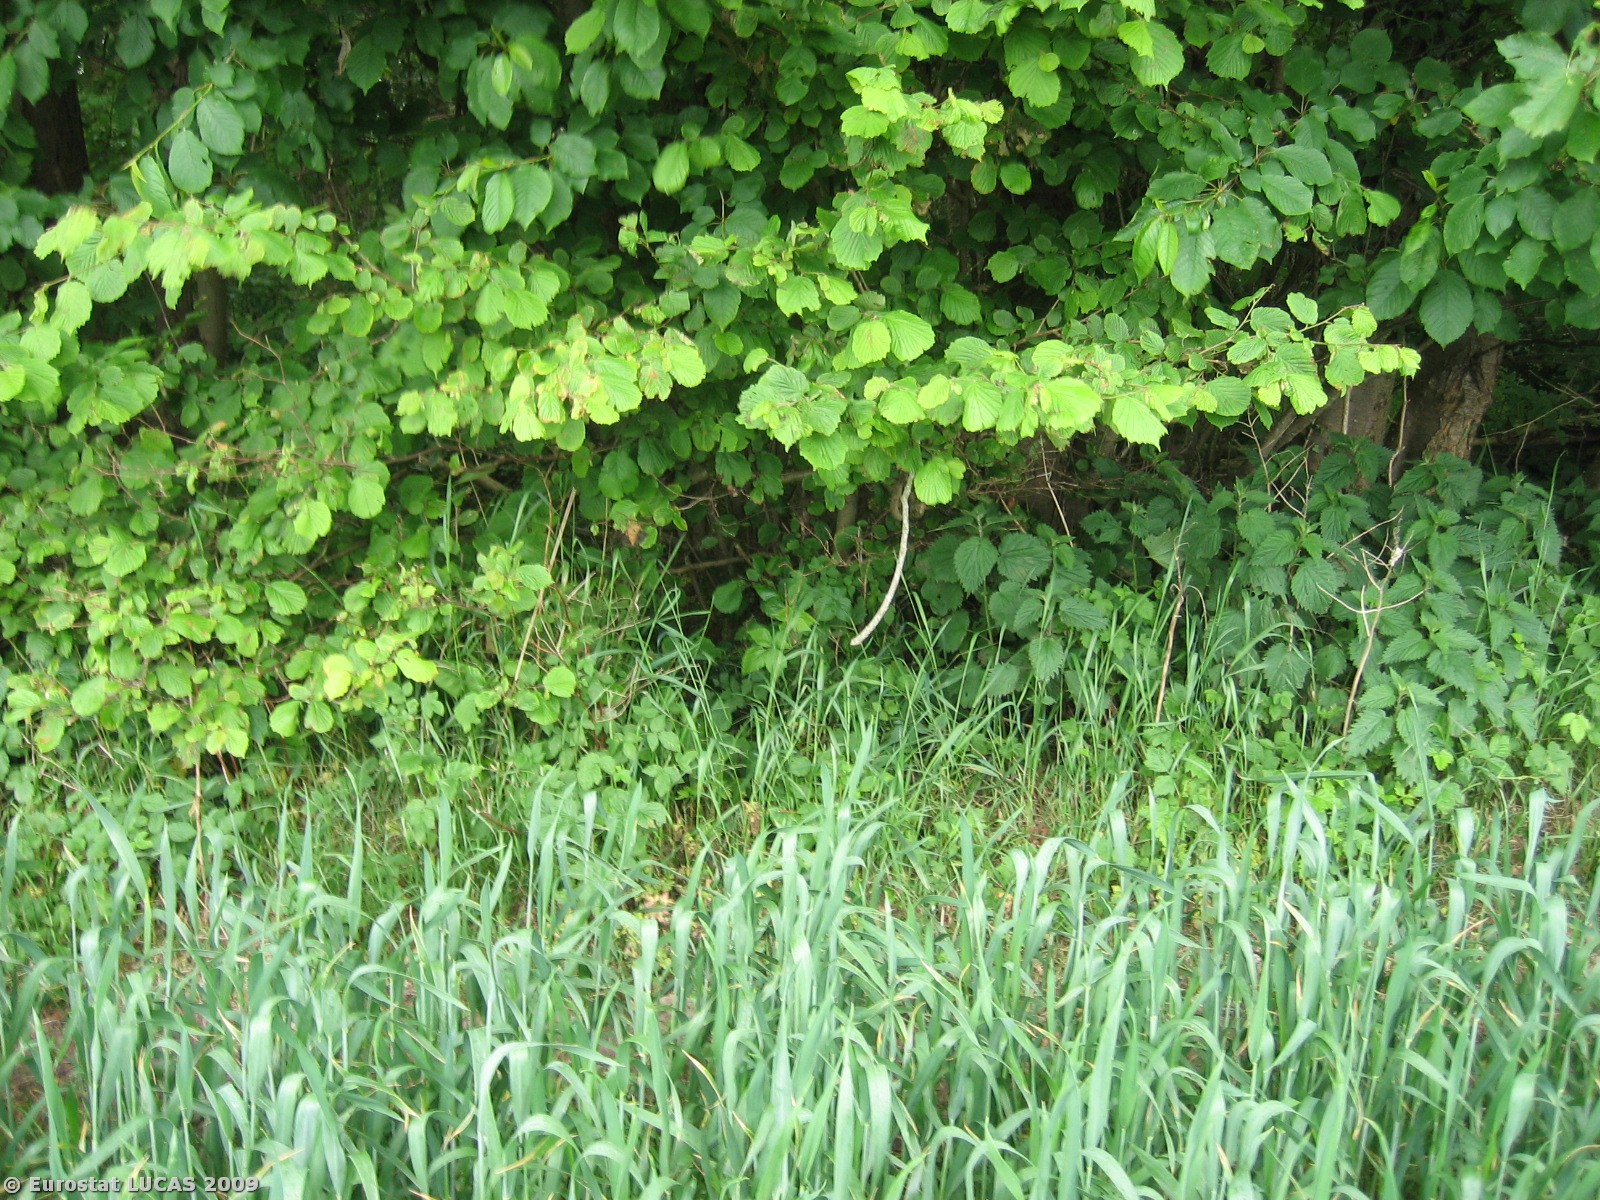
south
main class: Cropland
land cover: Common wheat
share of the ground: > 75 %
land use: Agriculture (excluding fallow land and kitchen gardens)
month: June
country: DK
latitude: 55.9719
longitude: 10.2081
